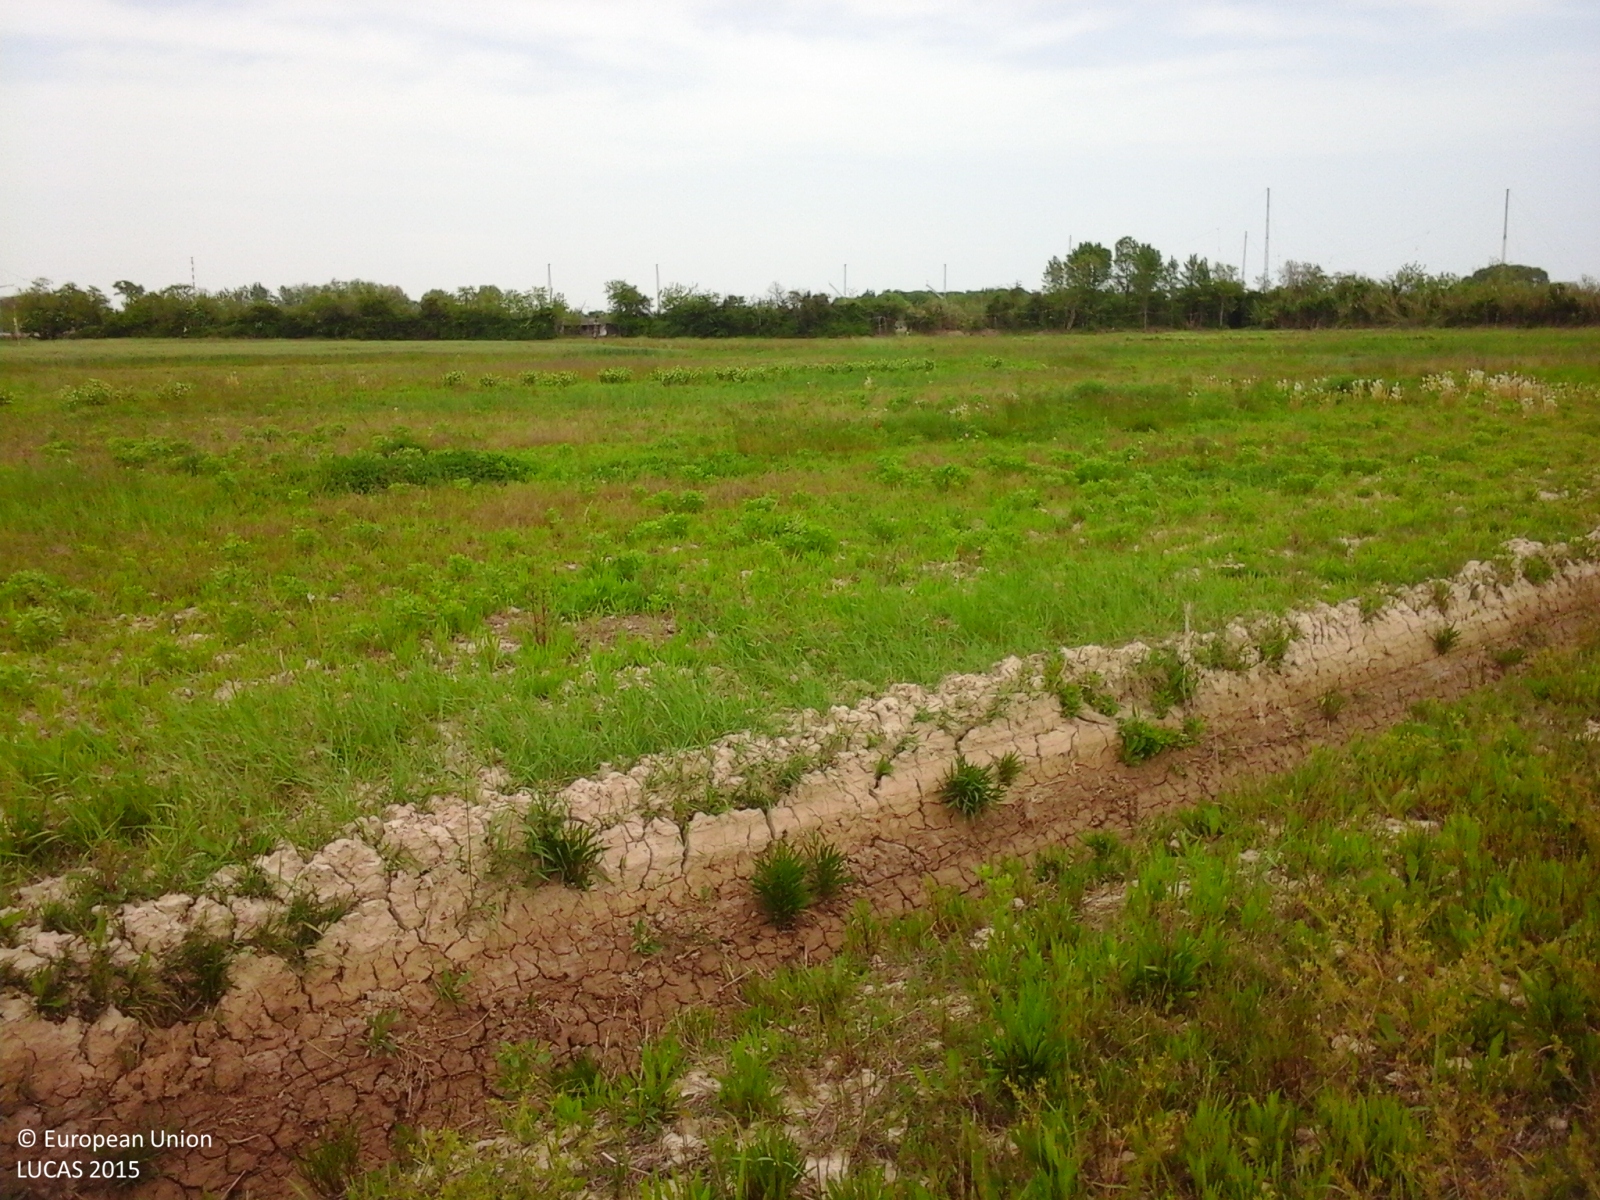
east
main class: Grassland
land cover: Spontaneously vegetated surfaces
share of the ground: > 75 %
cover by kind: herbaceous plants 80 %, consolidated bare surface 20 %
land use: Fallow land
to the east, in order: Spontaneously vegetated surfaces; Ditches and canals; Spontaneously vegetated surfaces; Ditches and canals; Spontaneously vegetated surfaces; Tracks; Ditches and canals; Spontaneously vegetated surfaces; Ditches and canals; Spontaneously vegetated surfaces; Ditches and canals; Spontaneously vegetated surfaces
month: May
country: IT
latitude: 45.5414
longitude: 12.7239
